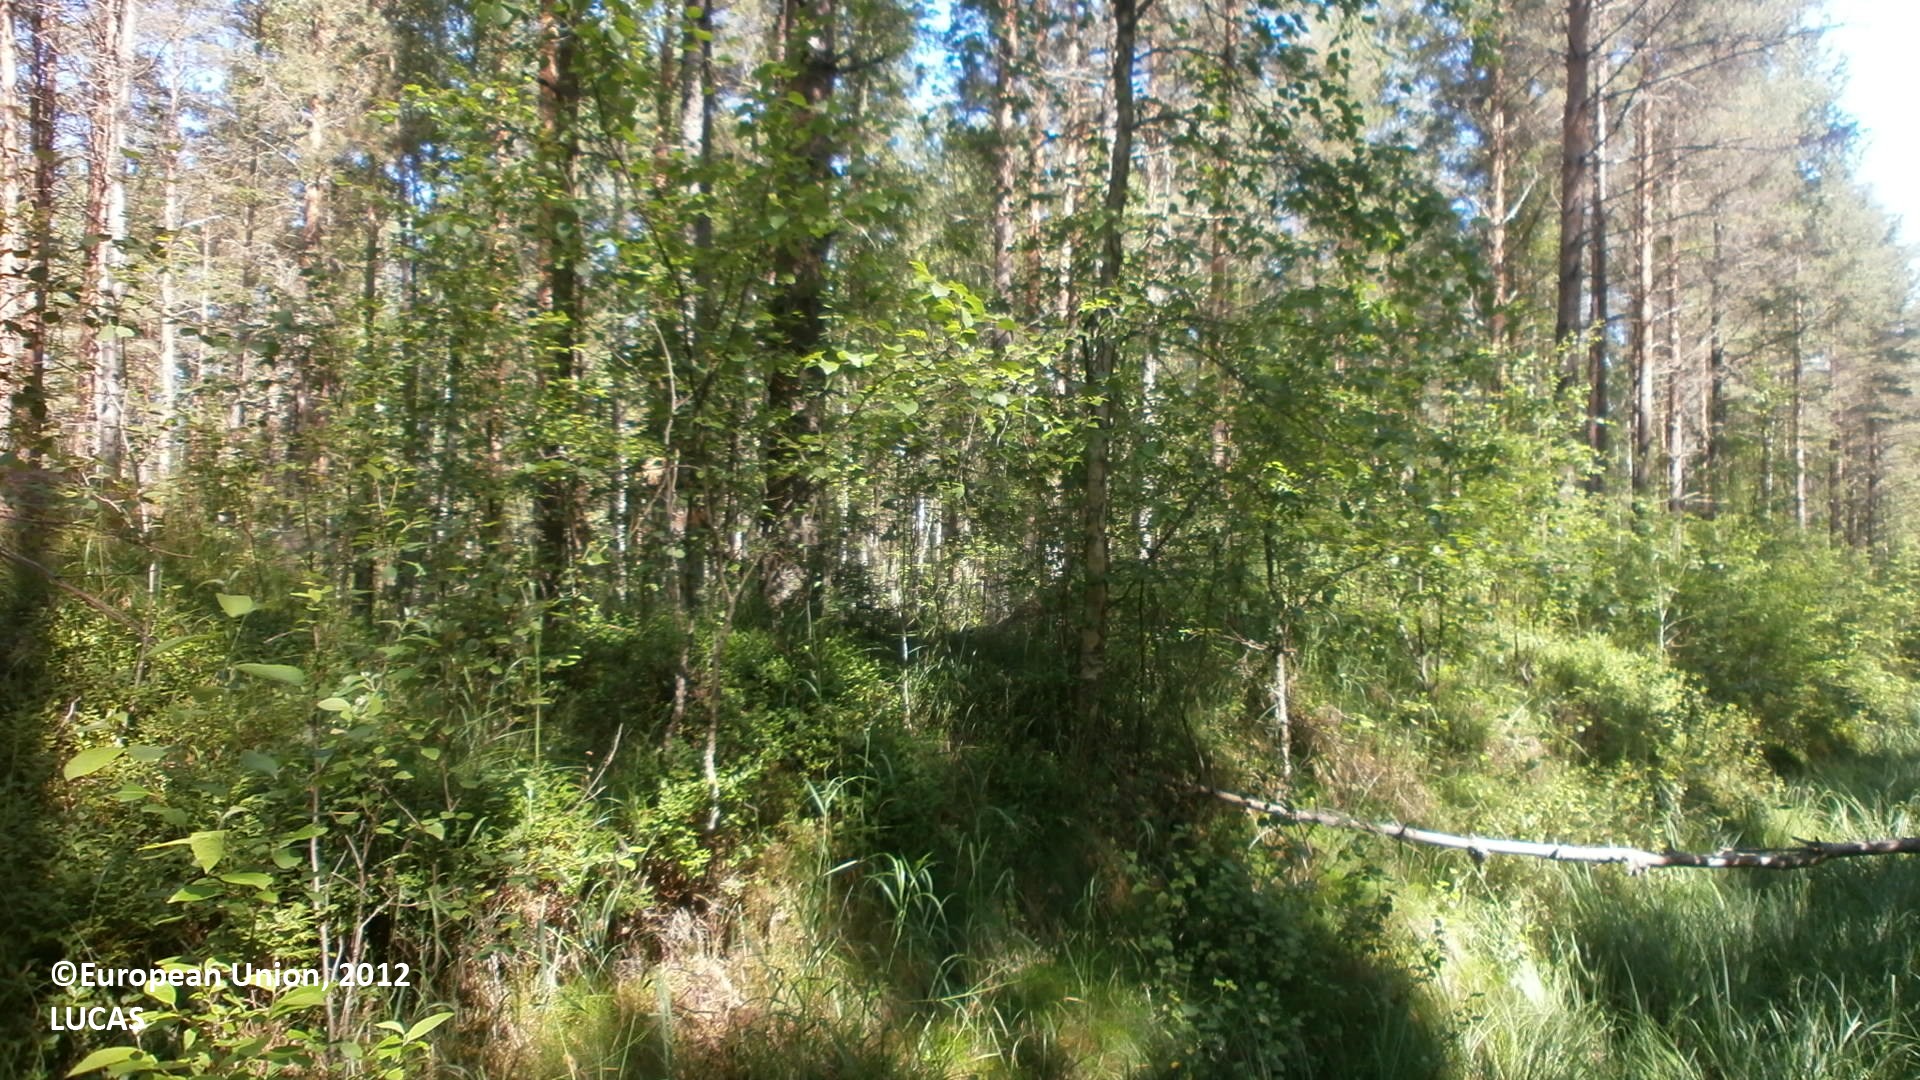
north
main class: Woodland
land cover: Pine dominated coniferous woodland
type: boreal forest
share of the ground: > 75 %
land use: Forestry
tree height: > 5 m
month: July
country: FI
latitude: 64.2950
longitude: 24.1368
